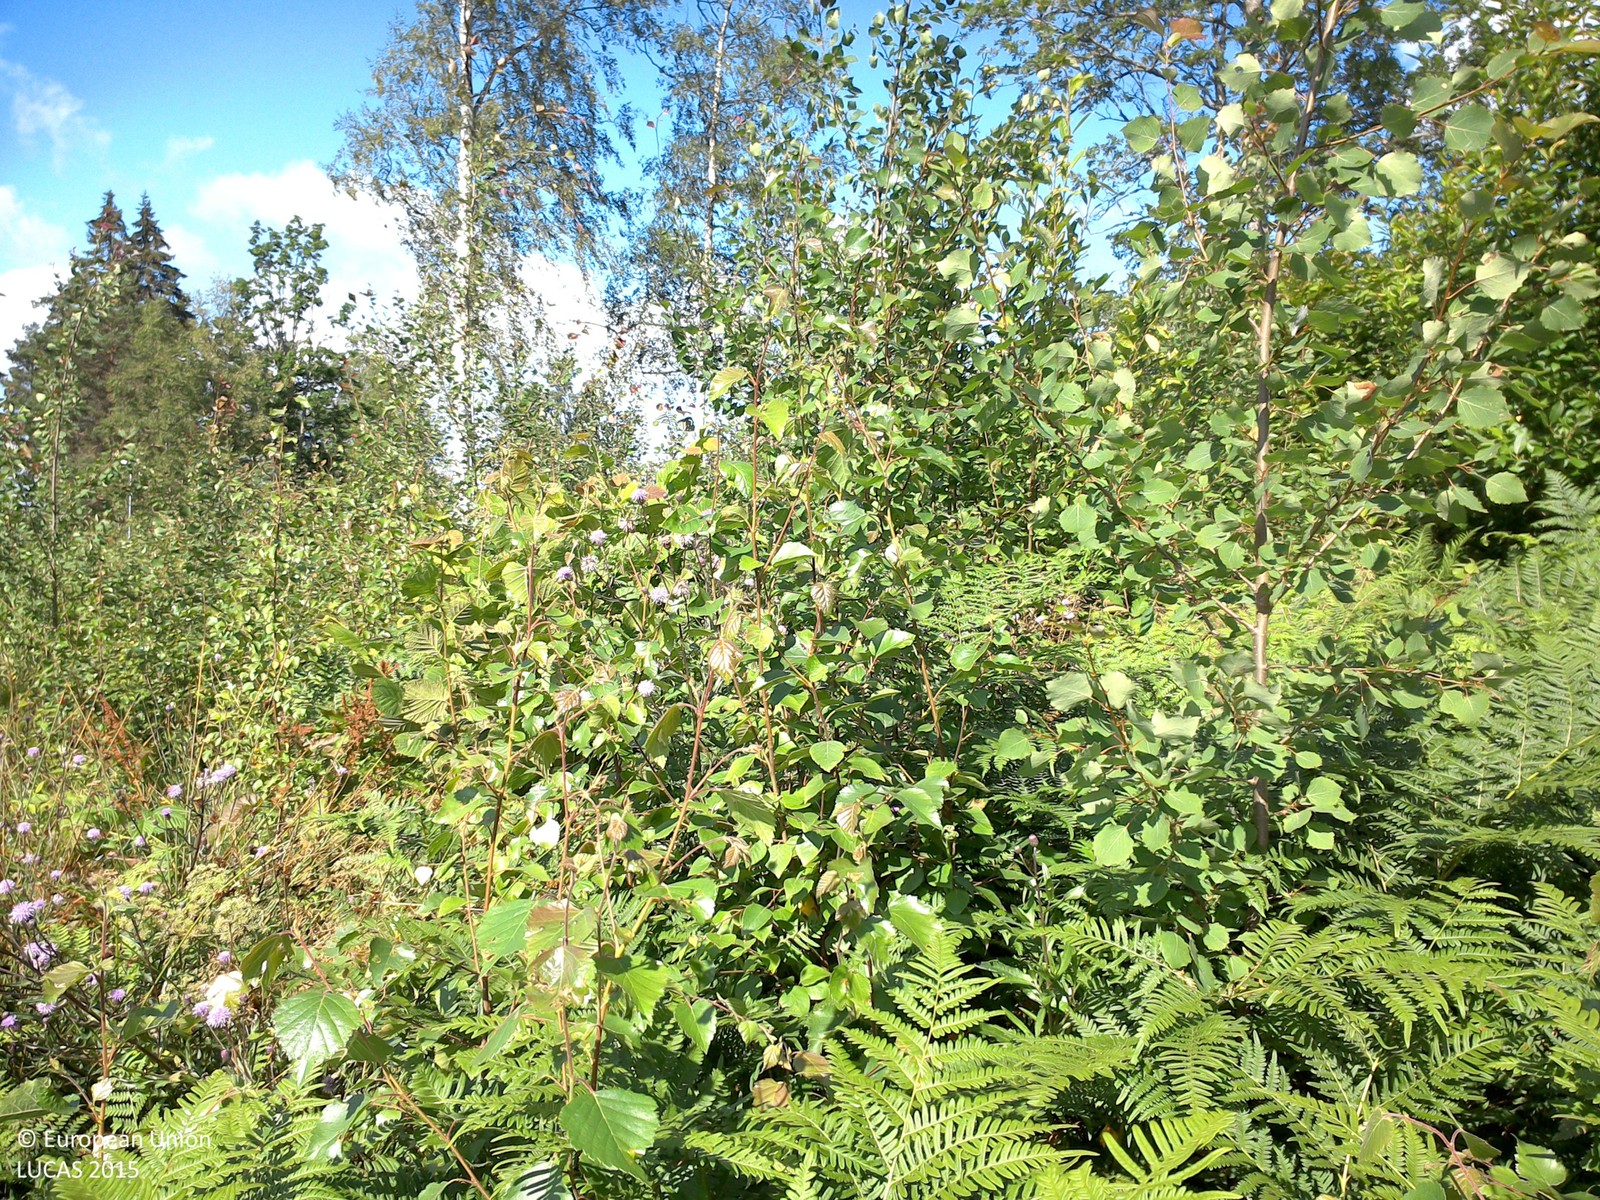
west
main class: Woodland
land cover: Broadleaved woodland
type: boreal forest
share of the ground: > 75 %
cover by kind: broadleaved forest trees 75 %, herbaceous plants 25 %
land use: Forestry
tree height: < 5 m
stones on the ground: < 10 %
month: July
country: SE
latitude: 57.9533
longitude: 14.8106
